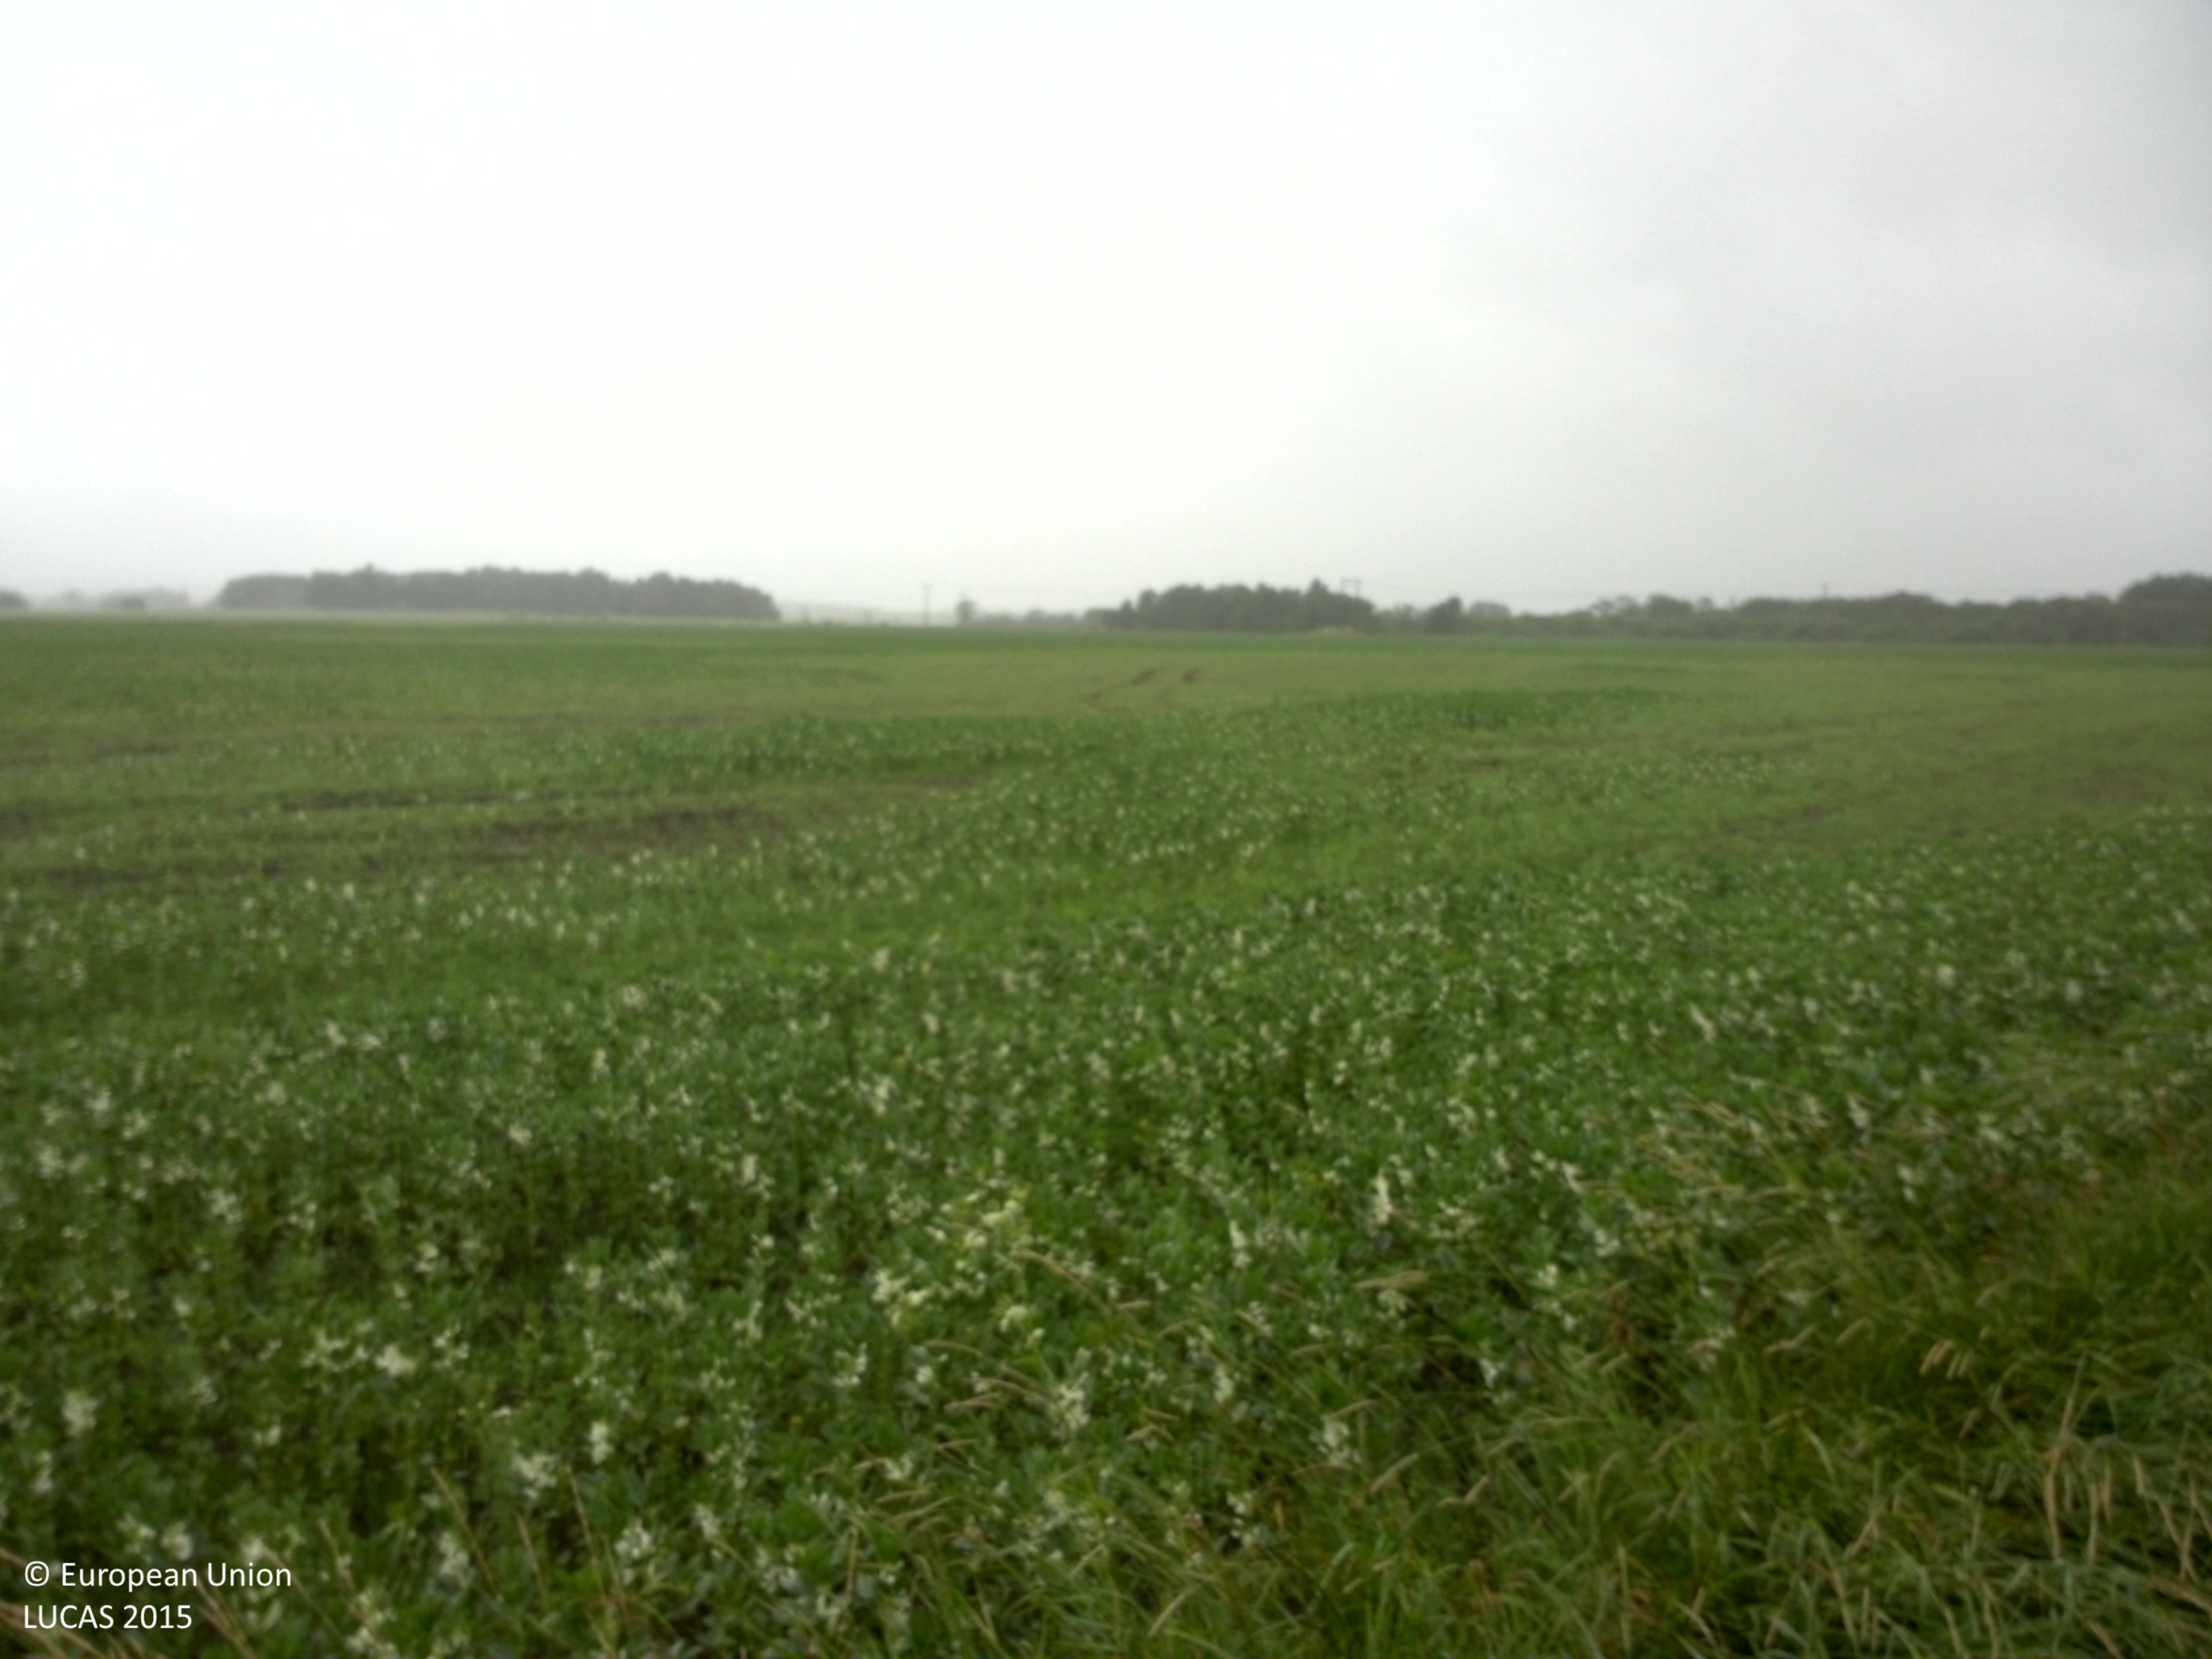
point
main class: Cropland
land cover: Dry pulses
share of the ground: > 75 %
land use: Agriculture (excluding fallow land and kitchen gardens)
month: July
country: SE
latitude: 58.5404
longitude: 13.9275
